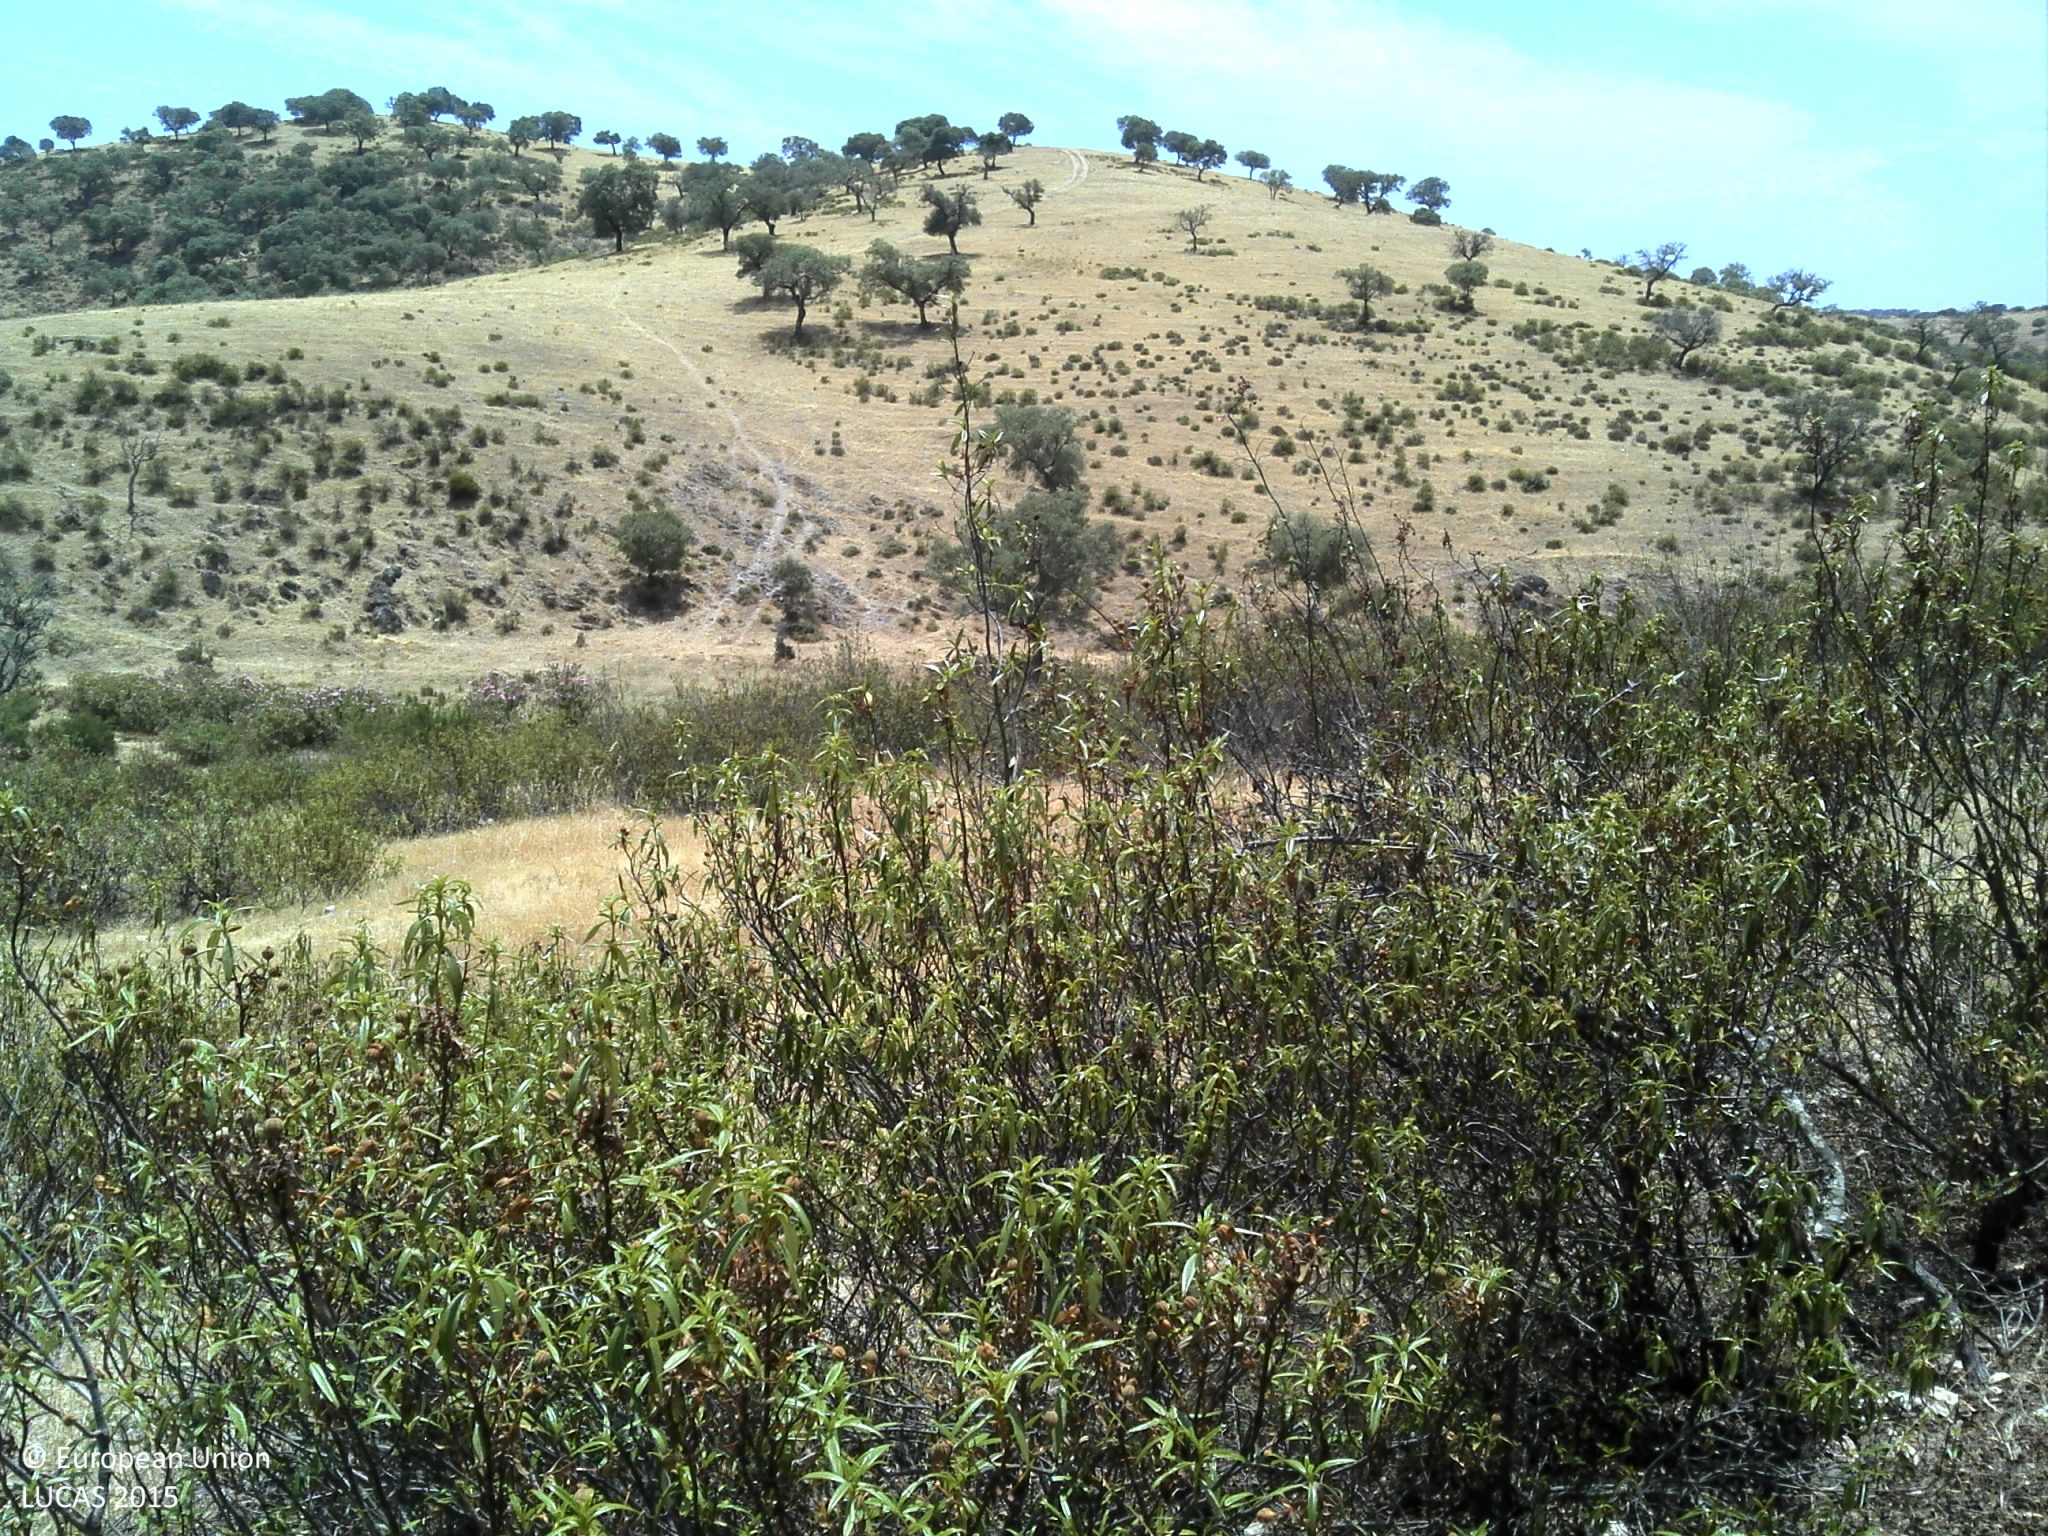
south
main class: Shrubland
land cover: Shrubland without tree cover
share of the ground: 50 - 75 %
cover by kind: shrubs 80 %, herbaceous plants 20 %
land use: Abandoned areas
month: July
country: PT
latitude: 38.1075
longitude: -7.2015
